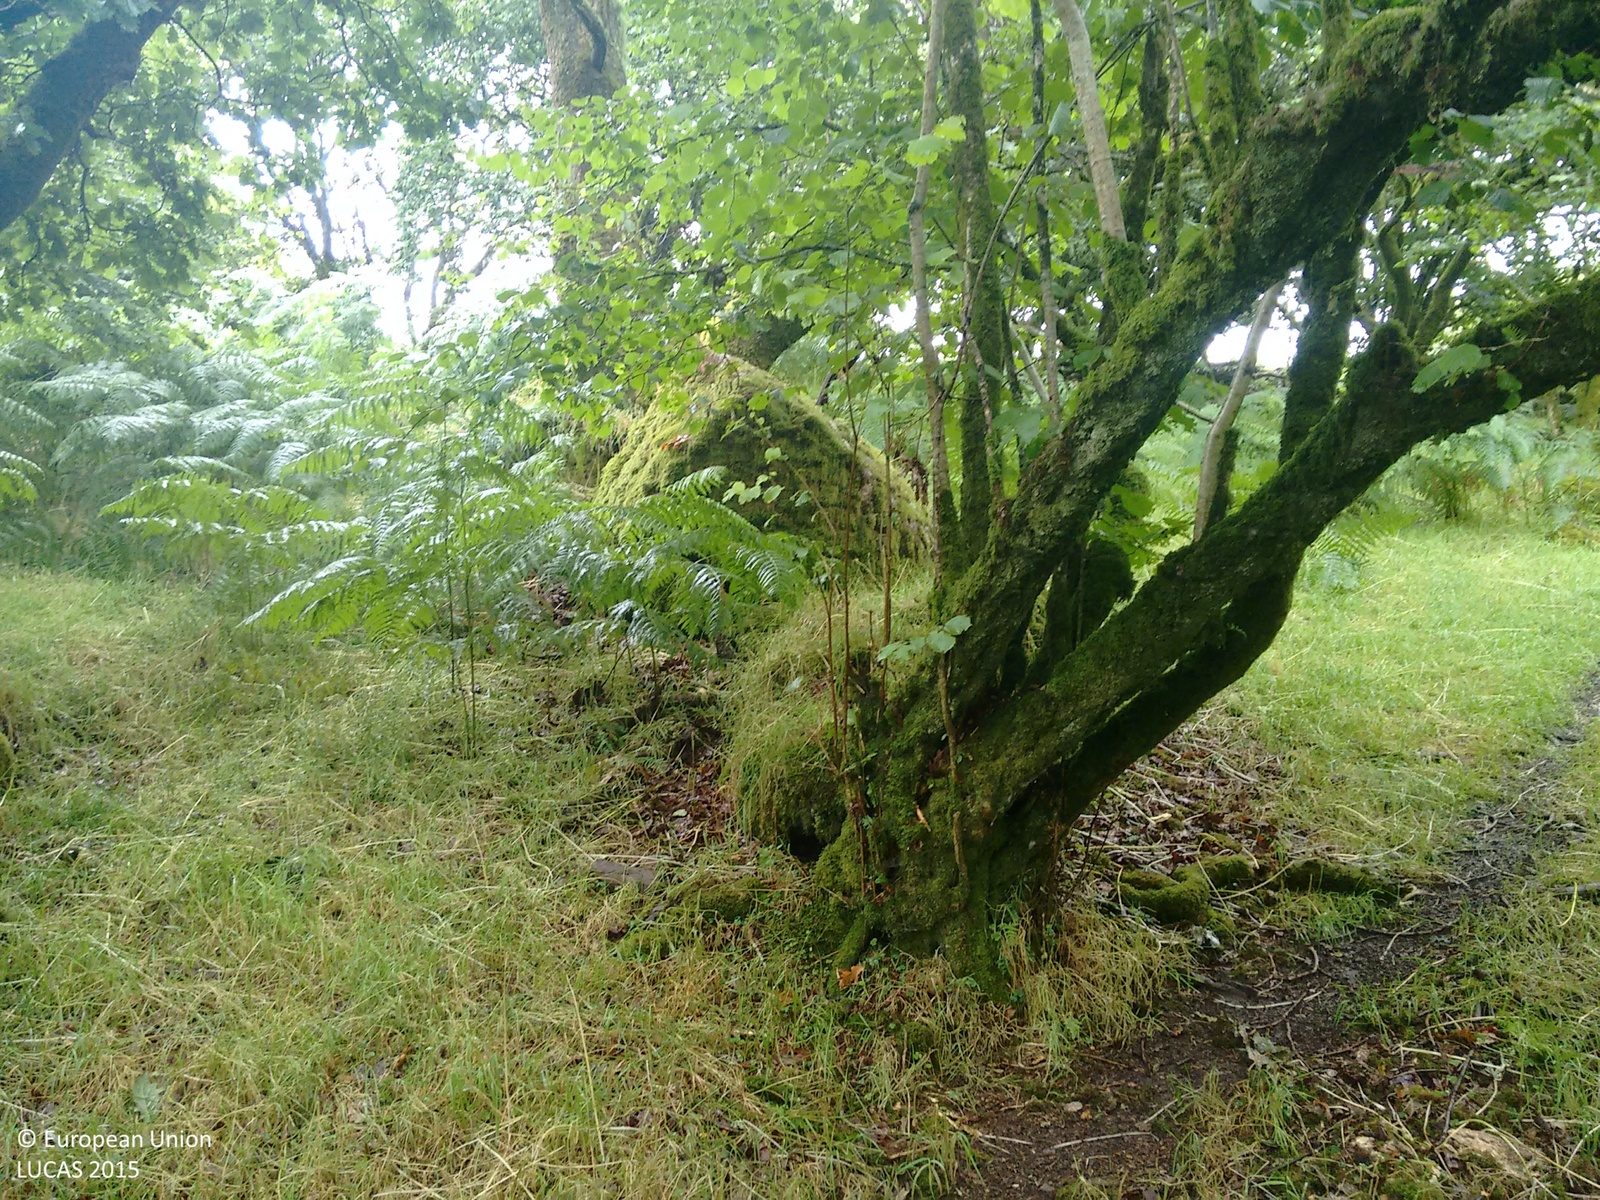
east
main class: Woodland
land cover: Broadleaved woodland
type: acidophilous oak and oak-birch forest
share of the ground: > 75 %
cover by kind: broadleaved forest trees 100 %
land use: Semi-natural and natural areas not in use
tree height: > 5 m
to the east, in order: Broadleaved woodland; Dry stone walls; Spontaneously vegetated surfaces; Fences; Dry stone walls; Shruby margins; Tracks; Grassland with sparse tree/shrub cover
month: August
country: GB
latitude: 50.5498
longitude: -4.0528
